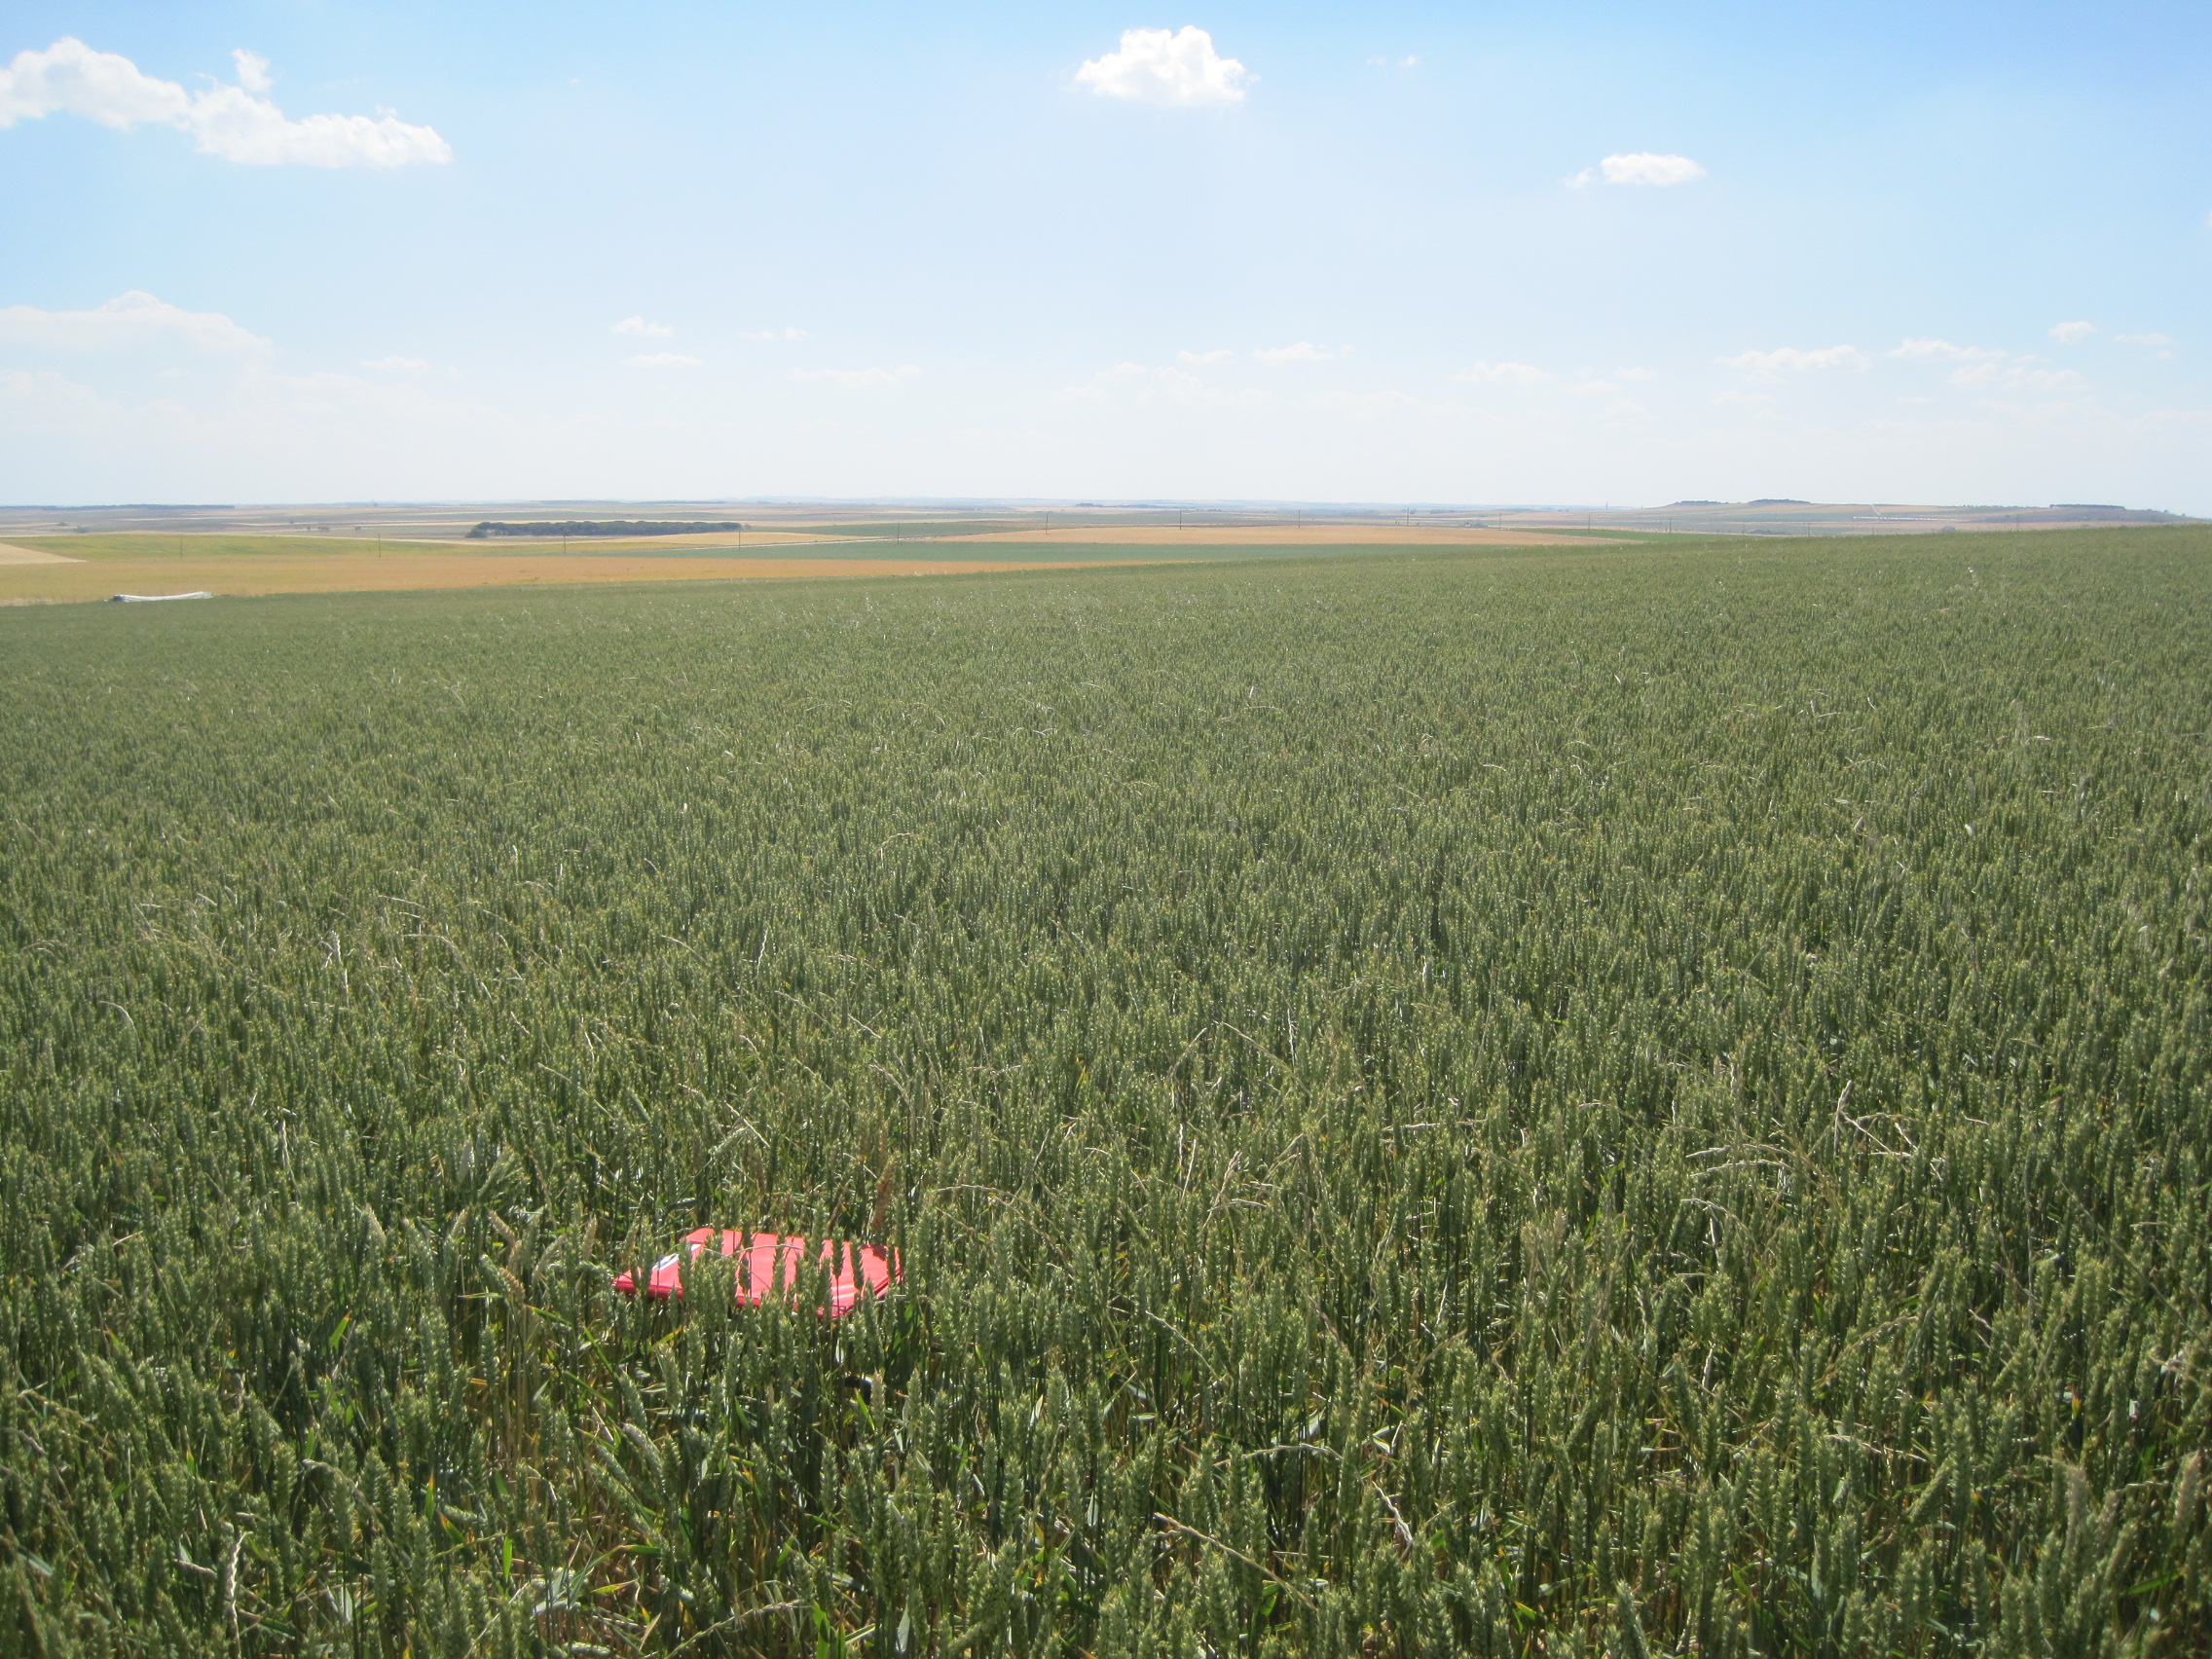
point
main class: Cropland
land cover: Common wheat
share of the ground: > 75 %
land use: Agriculture (excluding fallow land and kitchen gardens)
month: May
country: ES
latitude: 41.3219
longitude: -5.0397
